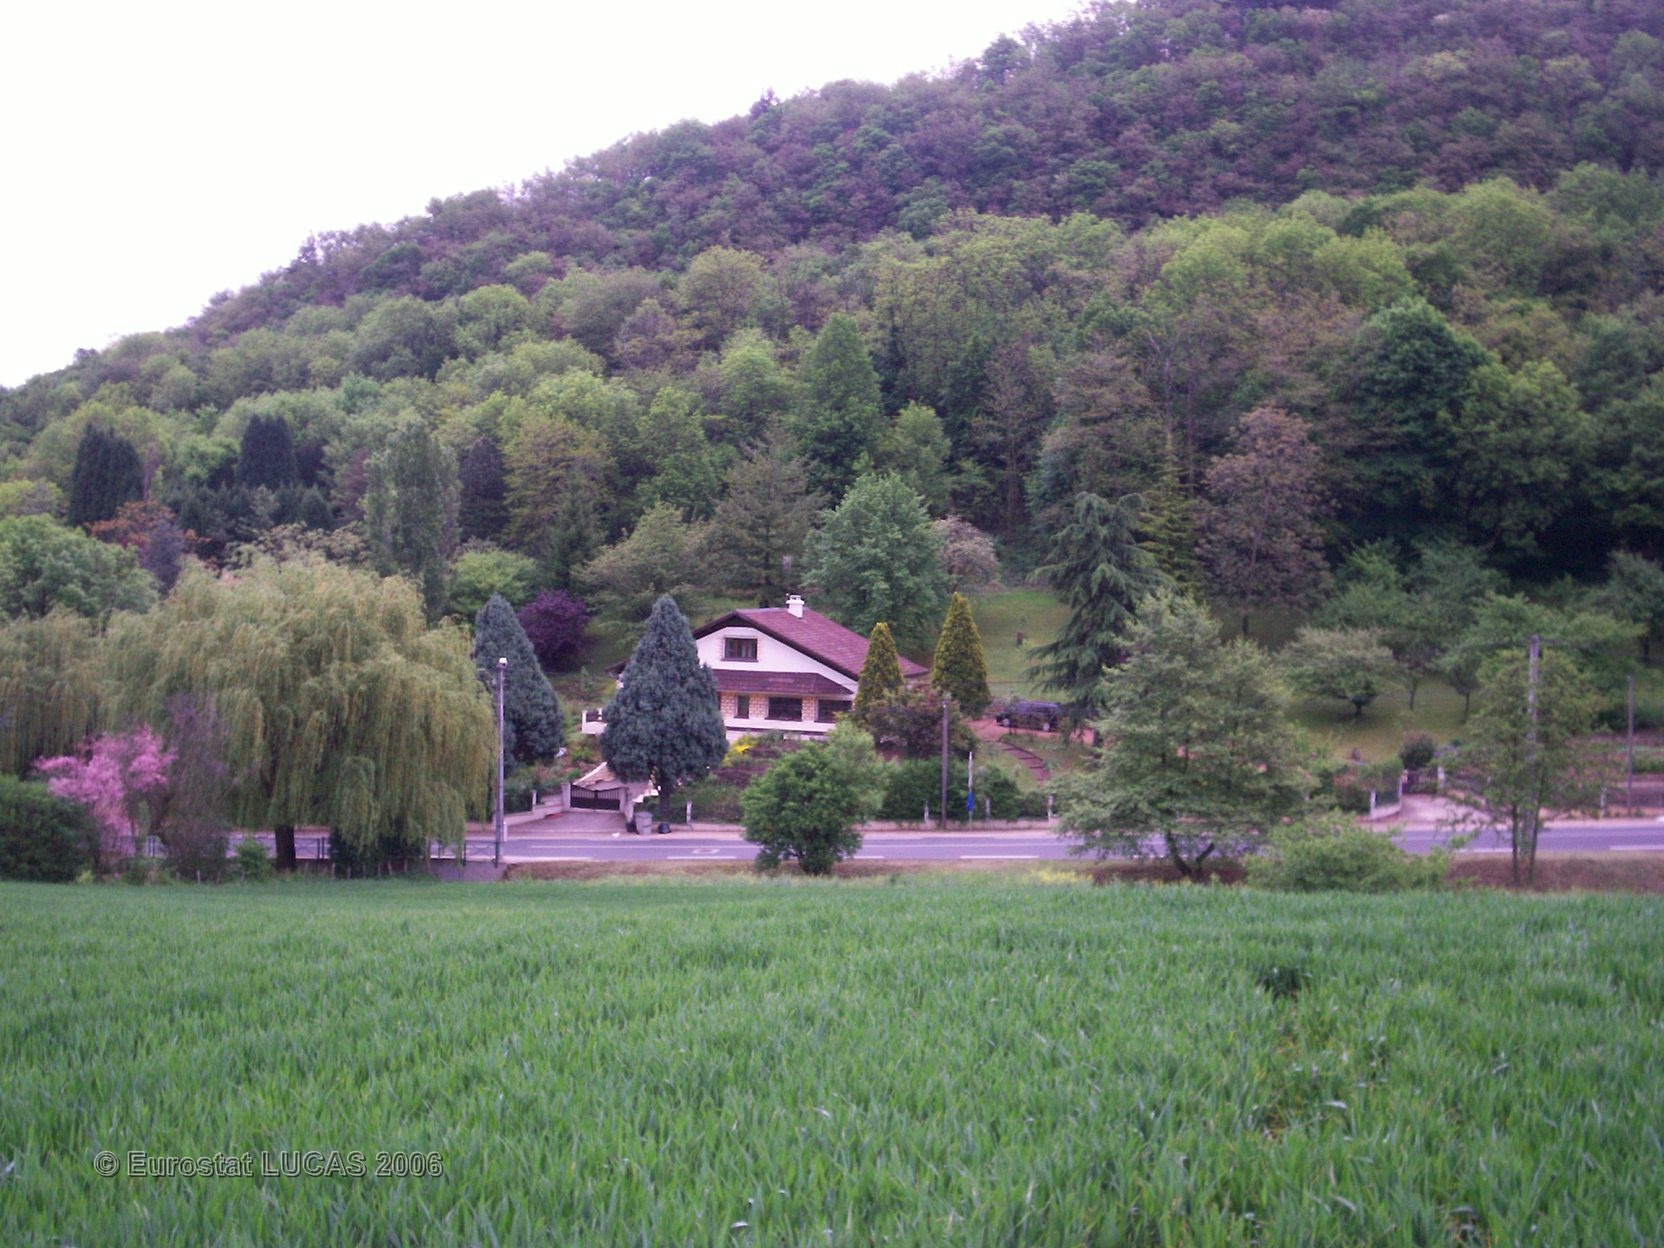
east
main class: Cropland
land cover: Common wheat
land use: Agriculture (excluding fallow land and kitchen gardens)
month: May
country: FR
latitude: 45.8644
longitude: 4.8122
